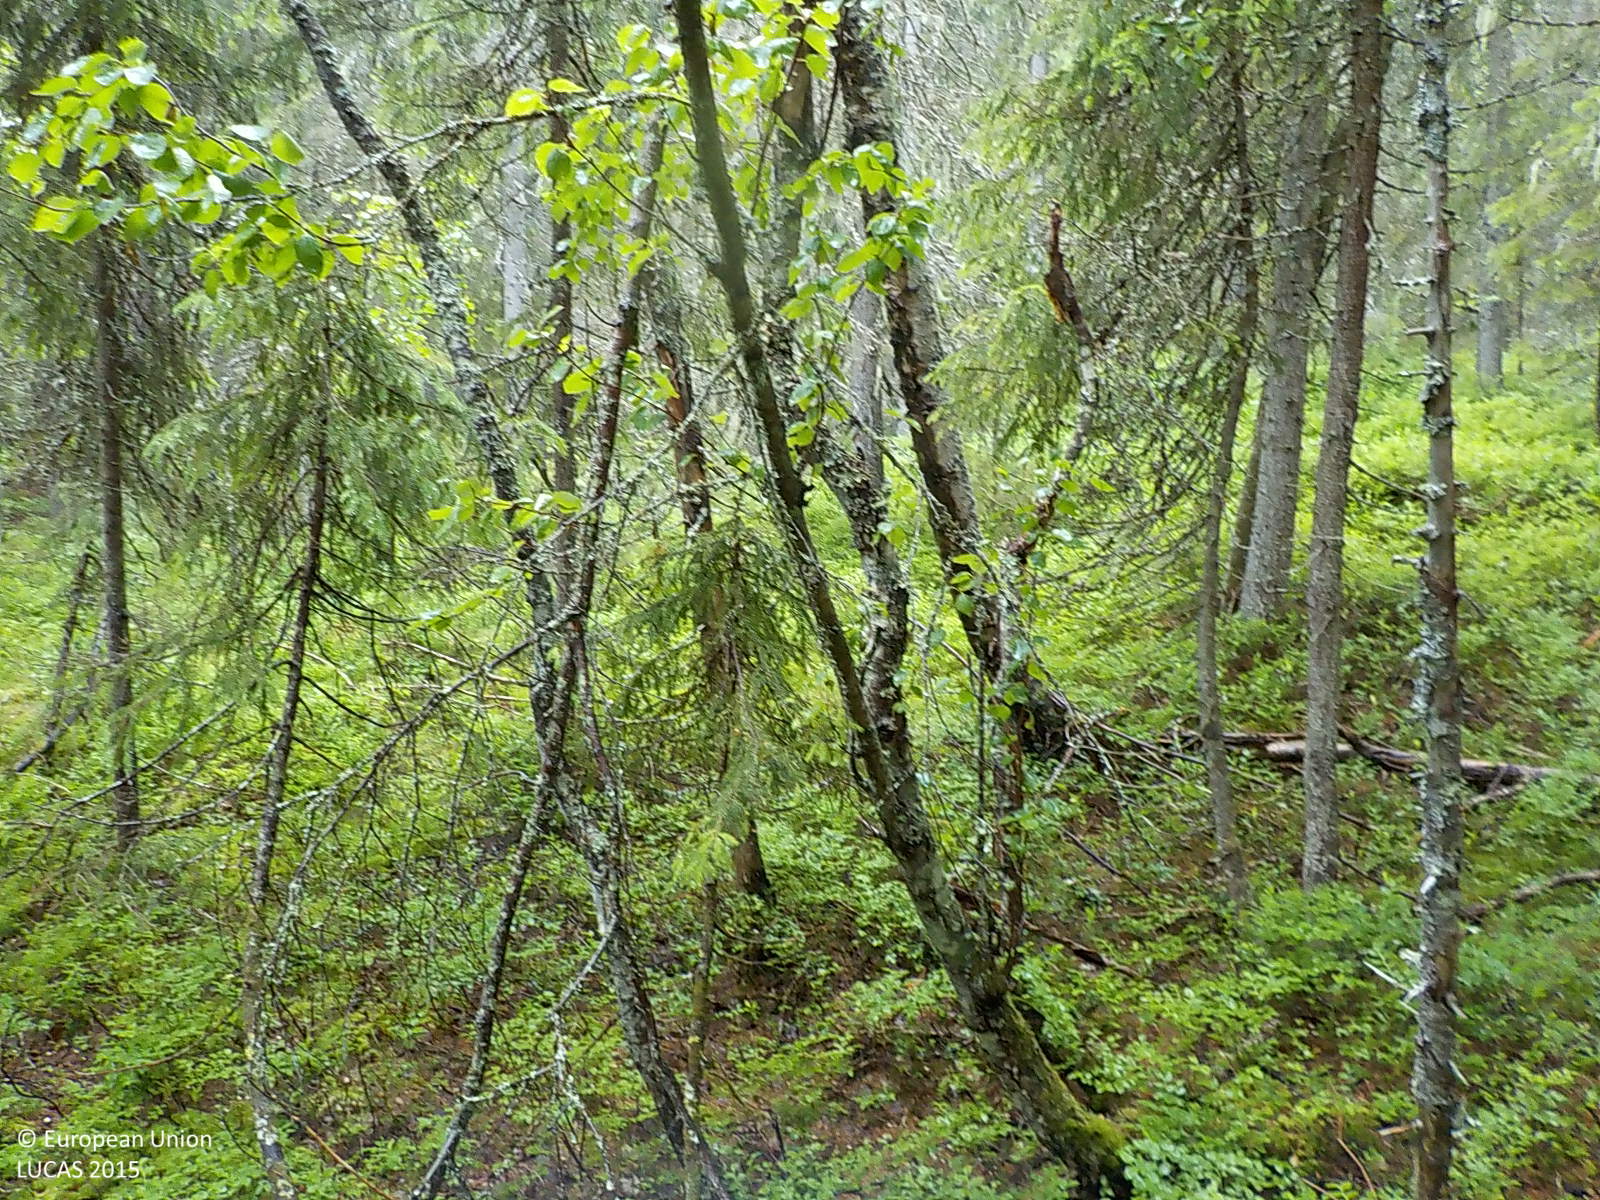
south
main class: Woodland
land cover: Spruce dominated coniferous woodland
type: boreal forest
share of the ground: 50 - 75 %
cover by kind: coniferous forest trees 60 %, shrubs 35 %, broadleaved forest trees 5 %
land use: Forestry
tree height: > 5 m
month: July
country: SE
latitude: 63.1963
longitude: 18.0271
